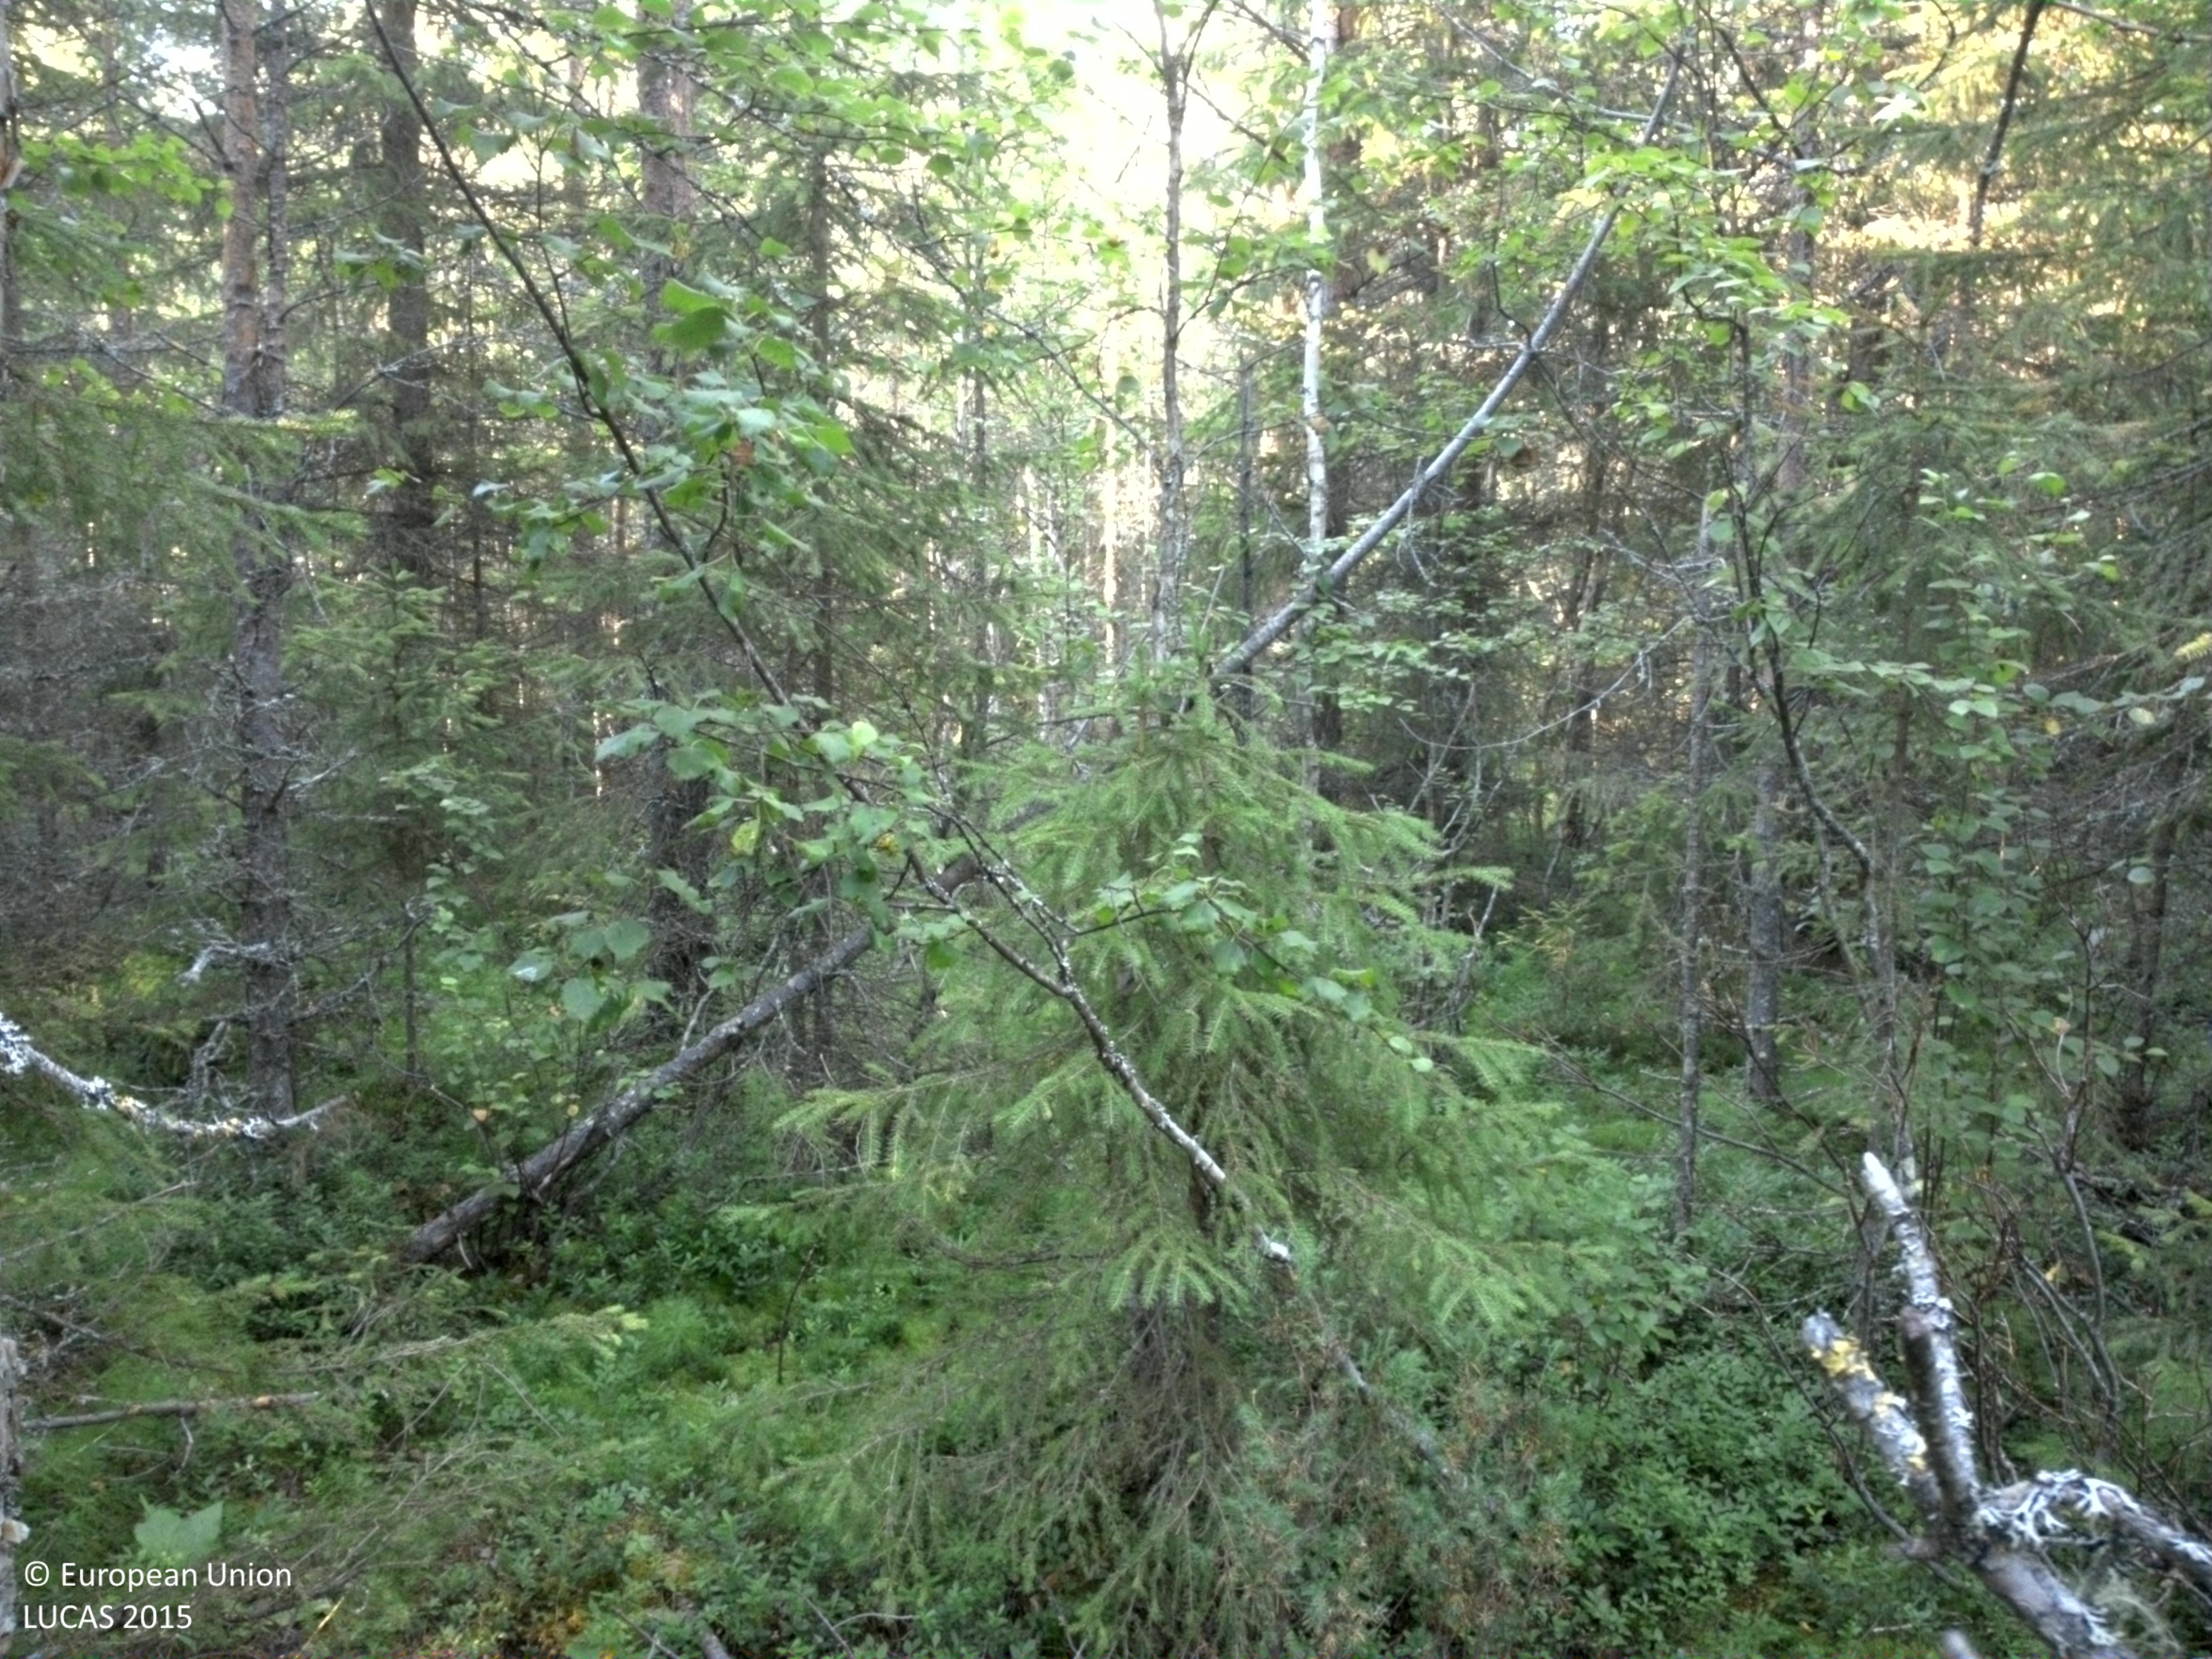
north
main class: Woodland
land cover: Pine dominated mixed woodland
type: boreal forest
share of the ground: > 75 %
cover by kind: coniferous forest trees 60 %, broadleaved forest trees 20 %, shrubs 20 %
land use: Forestry
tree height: > 5 m
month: August
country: SE
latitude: 64.5730
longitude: 20.8544
